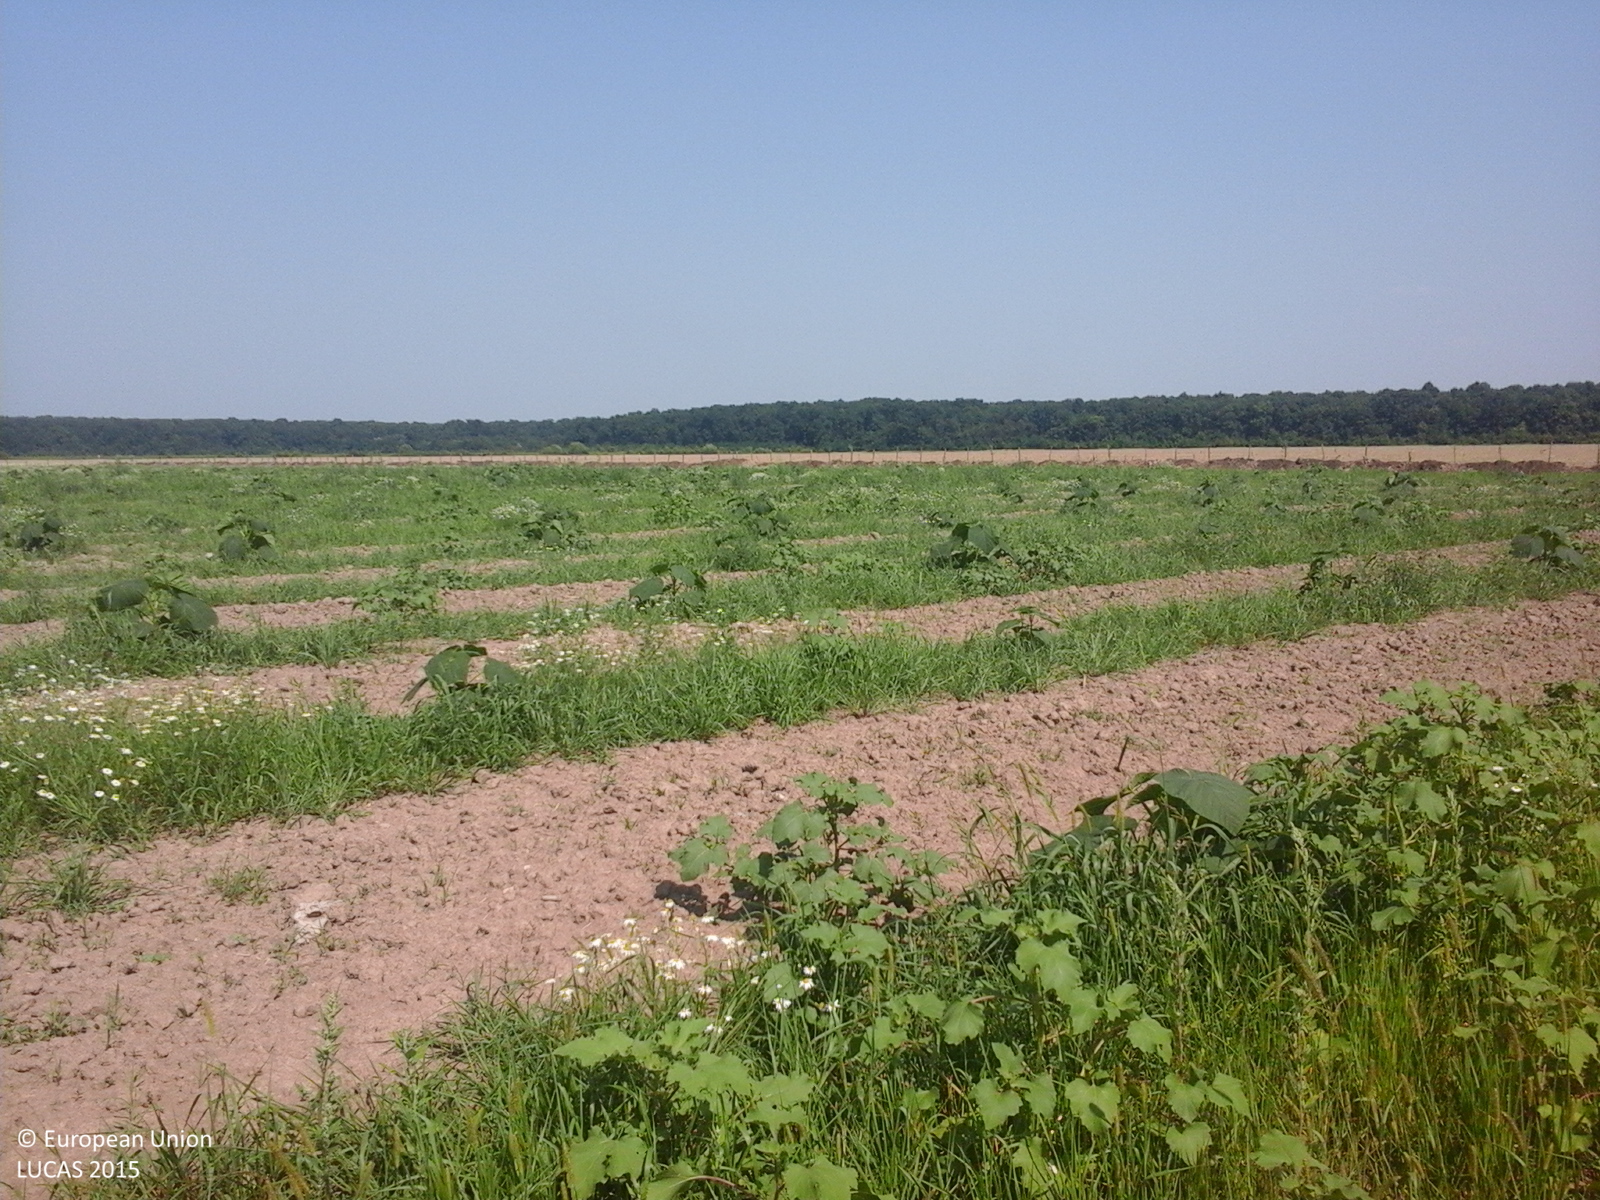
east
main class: Cropland
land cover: Nurseries
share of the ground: 10 - 25 %
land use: Forestry
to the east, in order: Nurseries; Grass margins; Fences; Grass margins; Common wheat
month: July
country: RO
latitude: 44.8360
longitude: 25.5672
